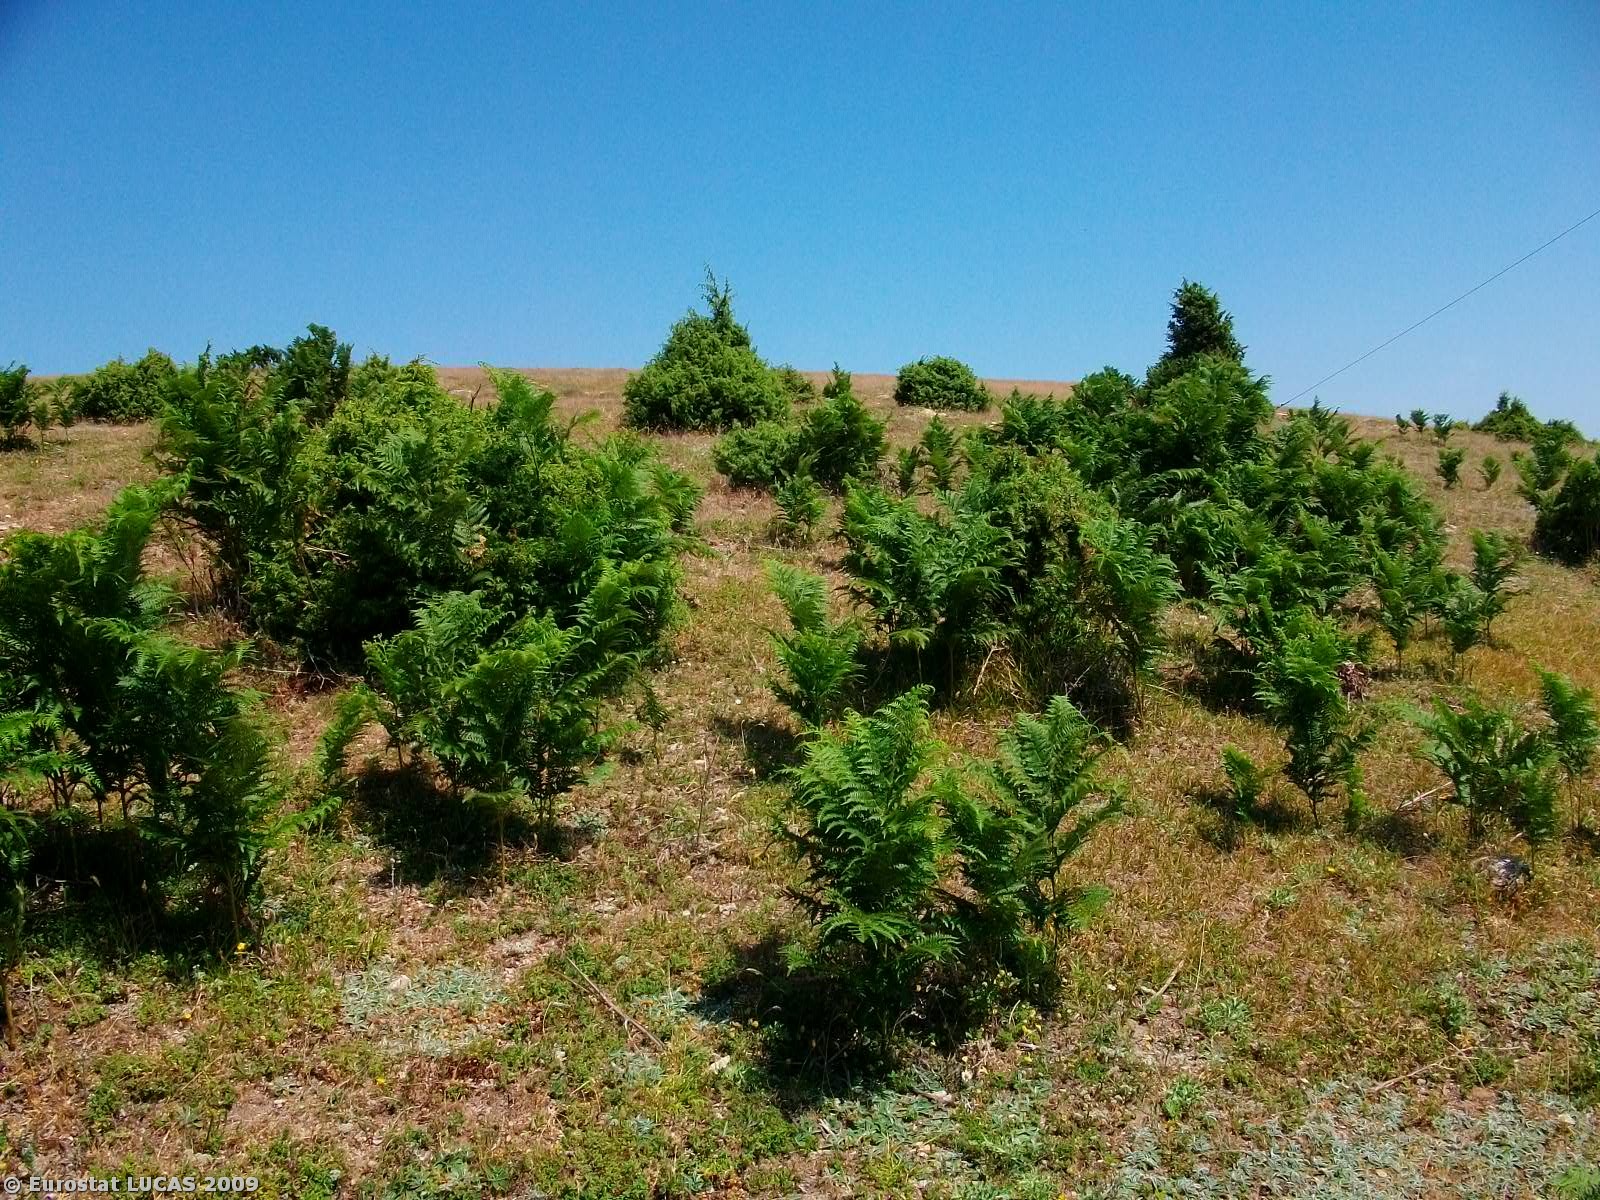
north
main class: Shrubland
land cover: Shrubland without tree cover
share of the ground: > 75 %
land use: Agriculture (excluding fallow land and kitchen gardens)
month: June
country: GR
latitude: 41.2108
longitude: 25.8636
